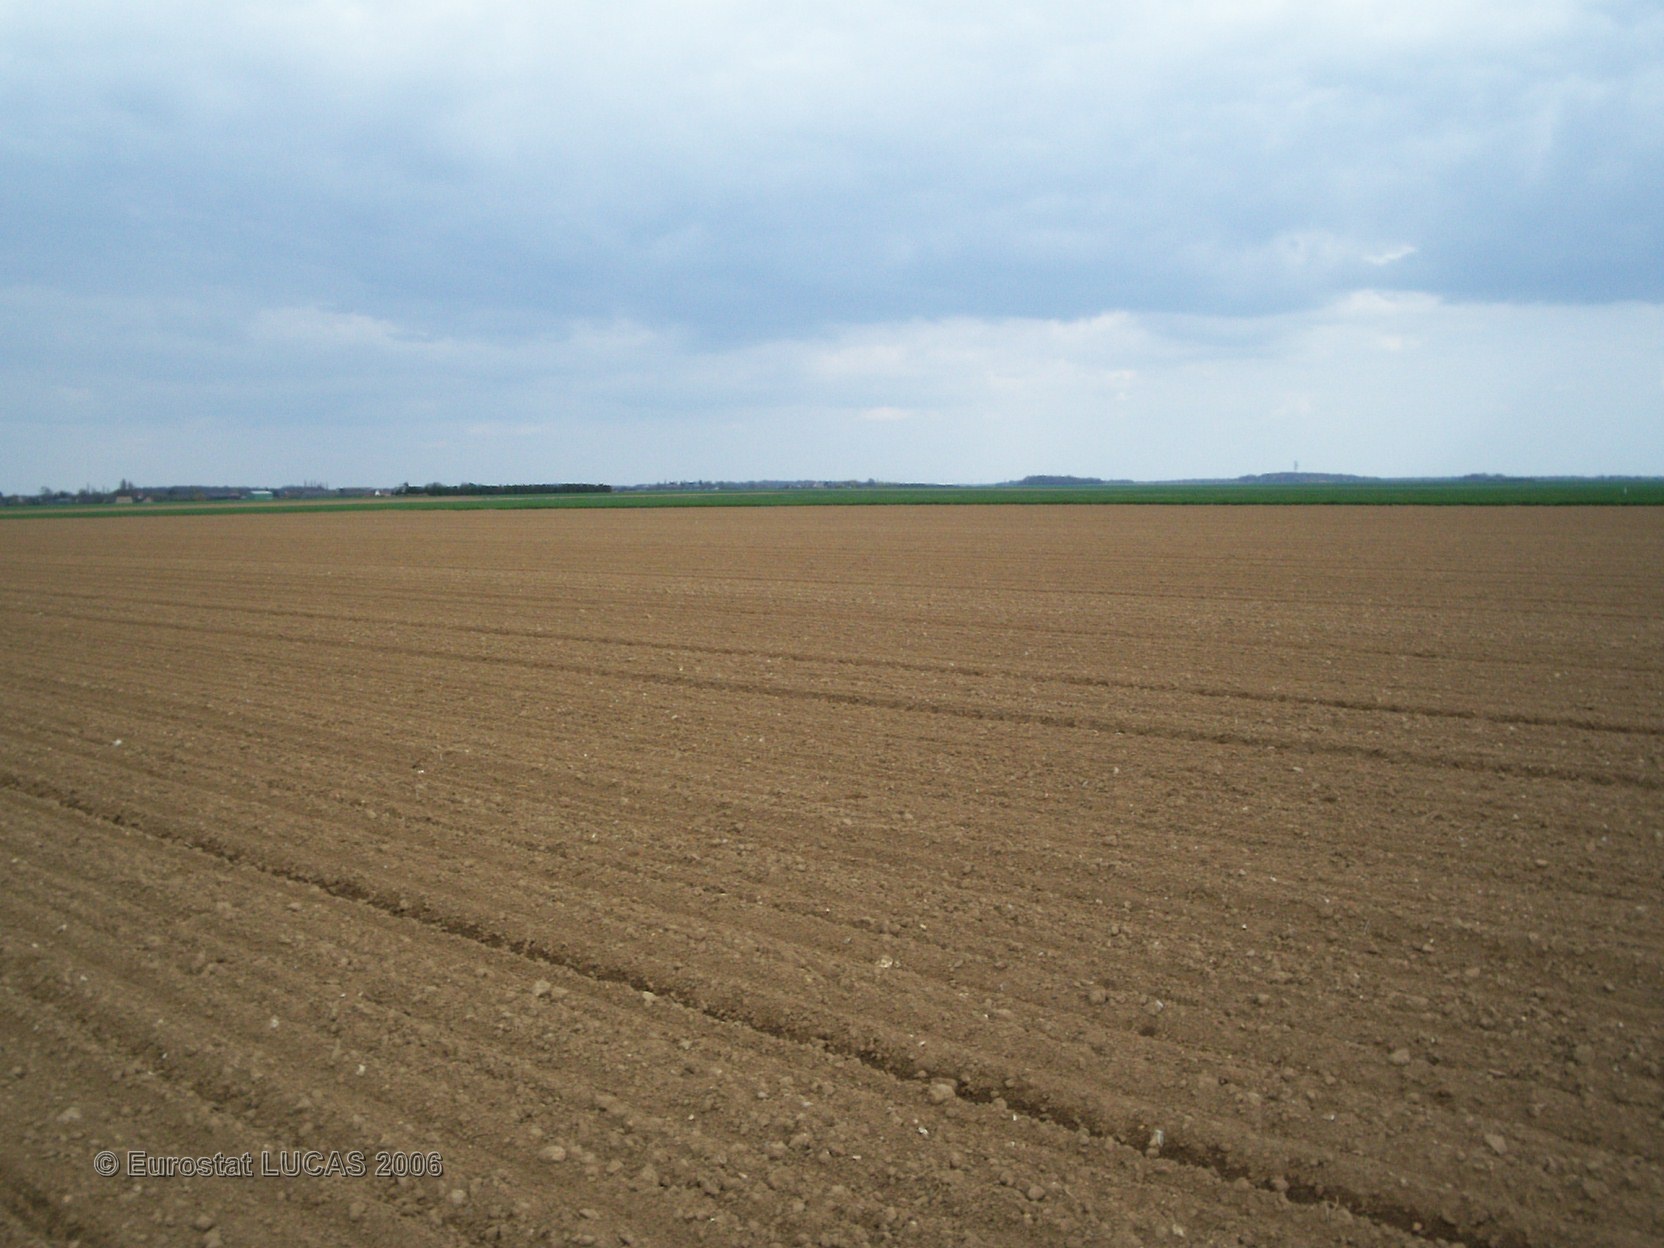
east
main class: Cropland
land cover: Sugar beet
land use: Agriculture (excluding fallow land and kitchen gardens)
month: April
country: FR
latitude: 49.0730
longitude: 1.0673
